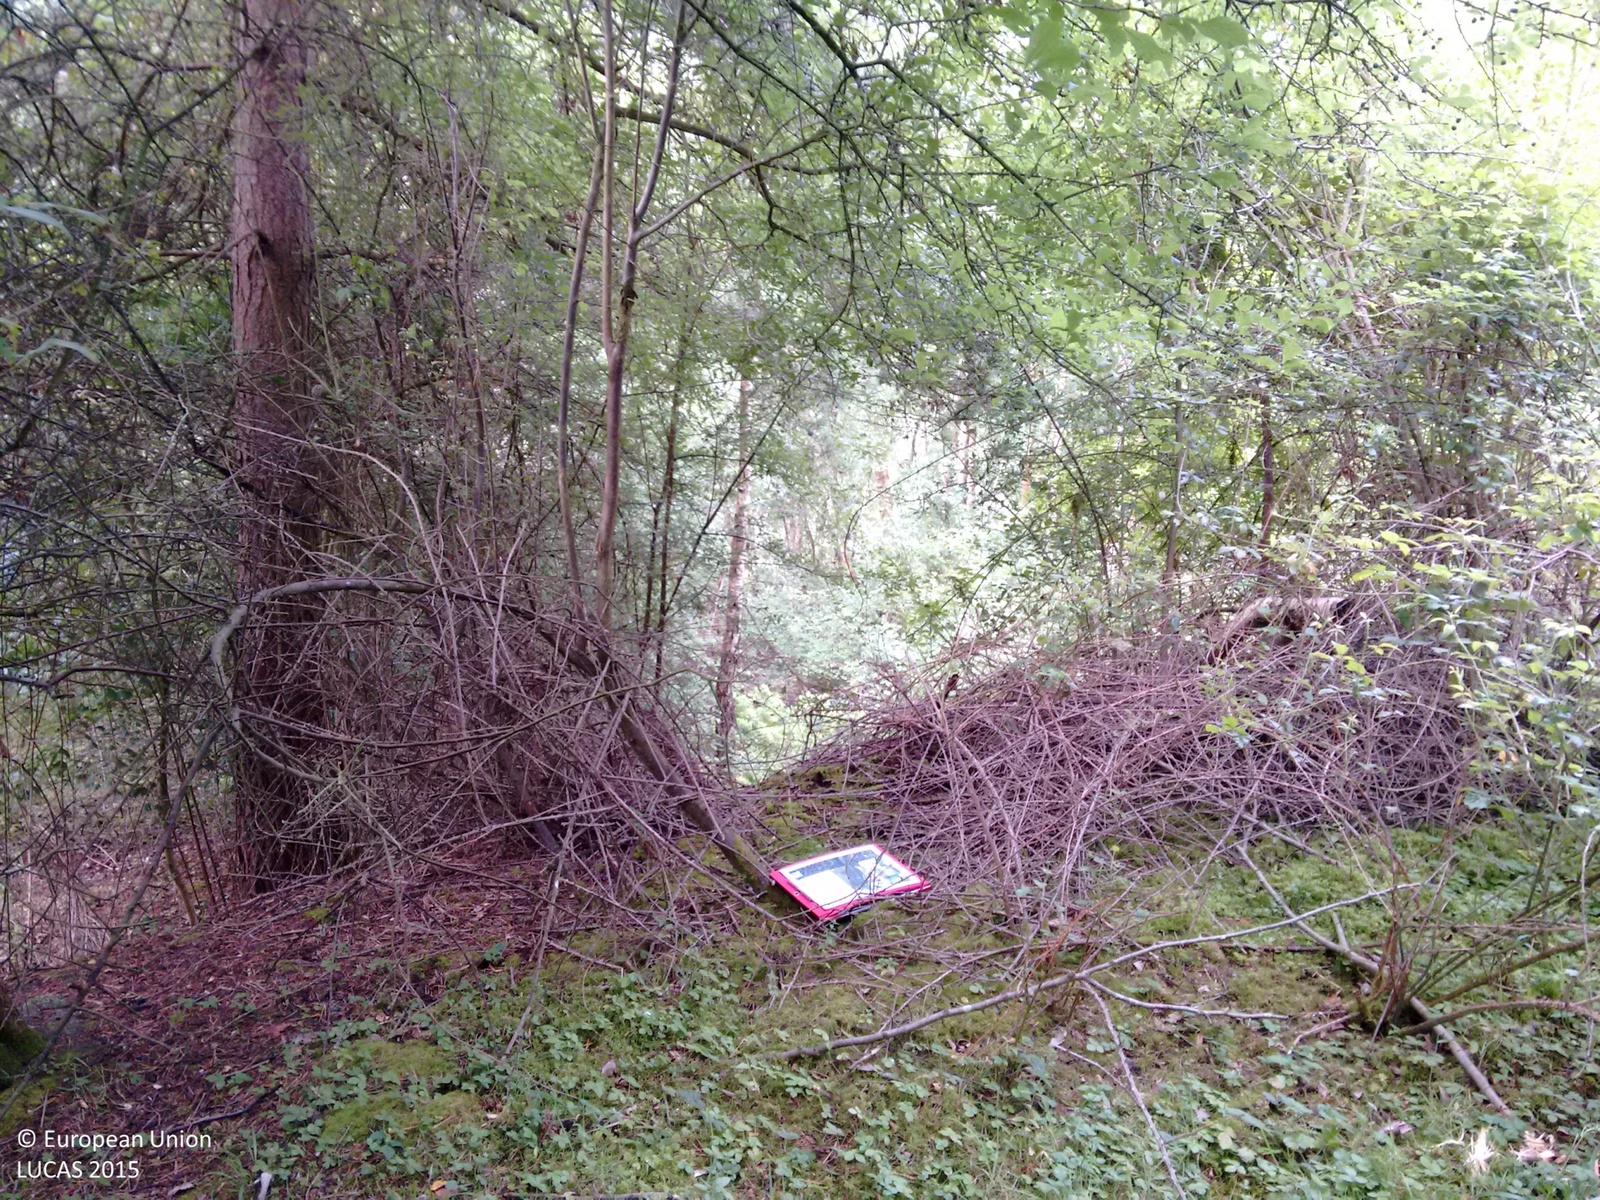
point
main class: Woodland
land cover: Other mixed woodland
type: mesophytic deciduous forest
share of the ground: > 75 %
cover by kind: broadleaved forest trees 70 %, coniferous forest trees 30 %
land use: Forestry
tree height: > 5 m
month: July
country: GB
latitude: 52.4769
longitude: -0.6553
